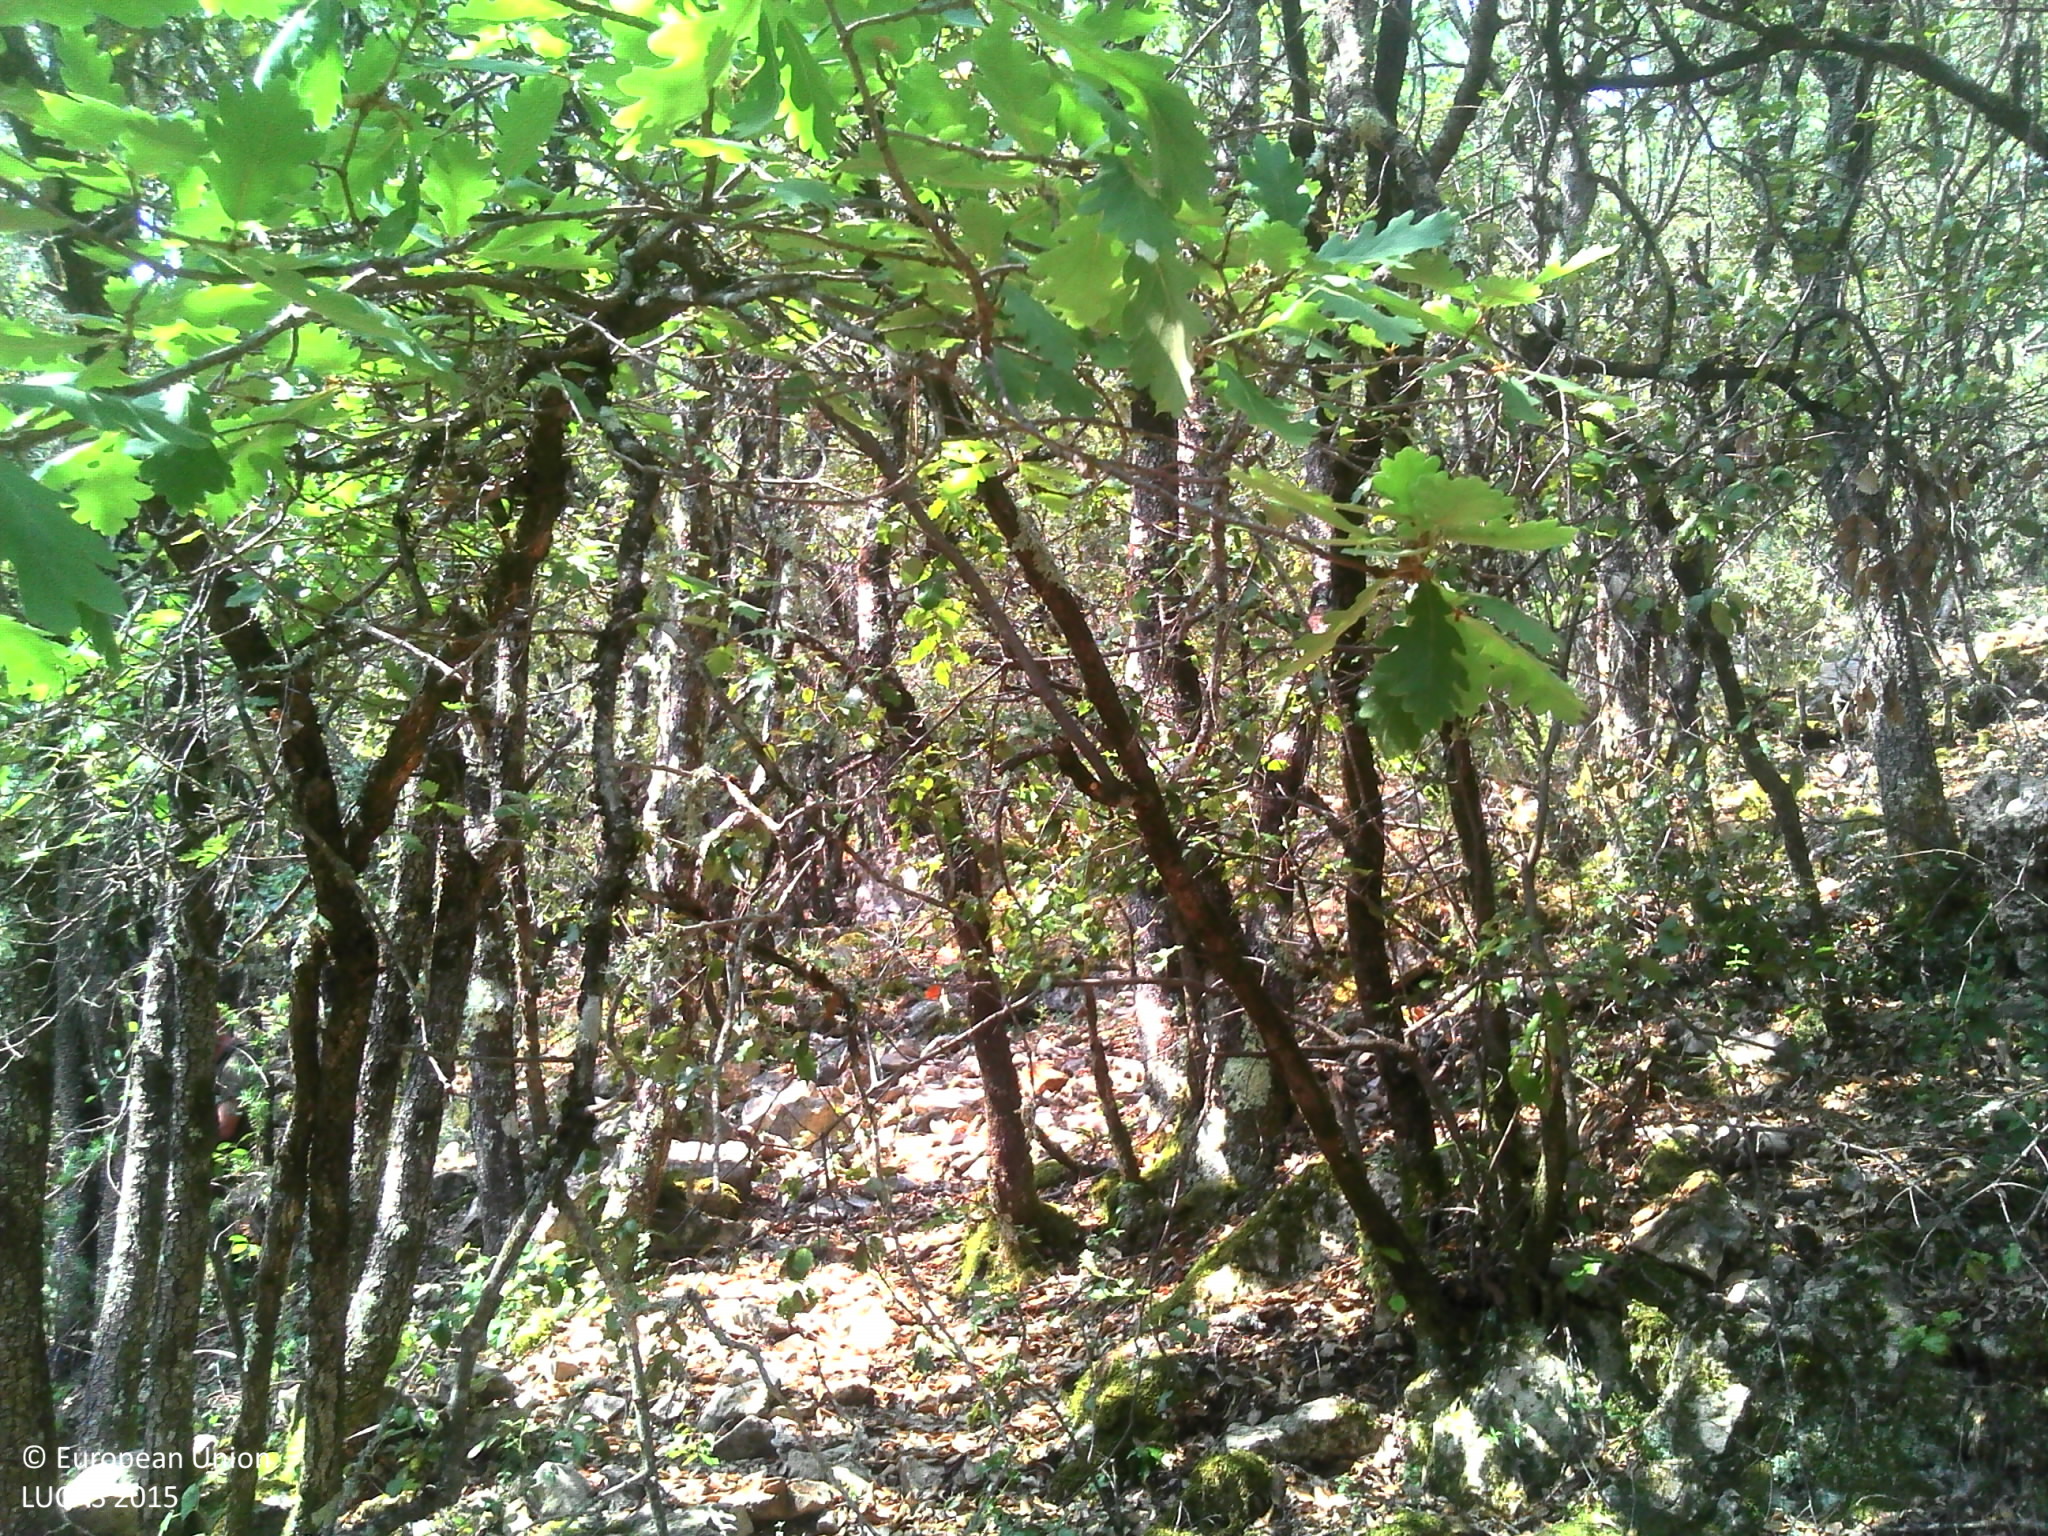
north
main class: Woodland
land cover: Broadleaved woodland
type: thermophilous deciduous forest
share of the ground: > 75 %
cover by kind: broadleaved forest trees 90 %, unconsolidated bare surface 10 %
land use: Semi-natural and natural areas not in use
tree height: > 5 m
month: August
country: FR
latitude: 43.6355
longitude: 6.3270
